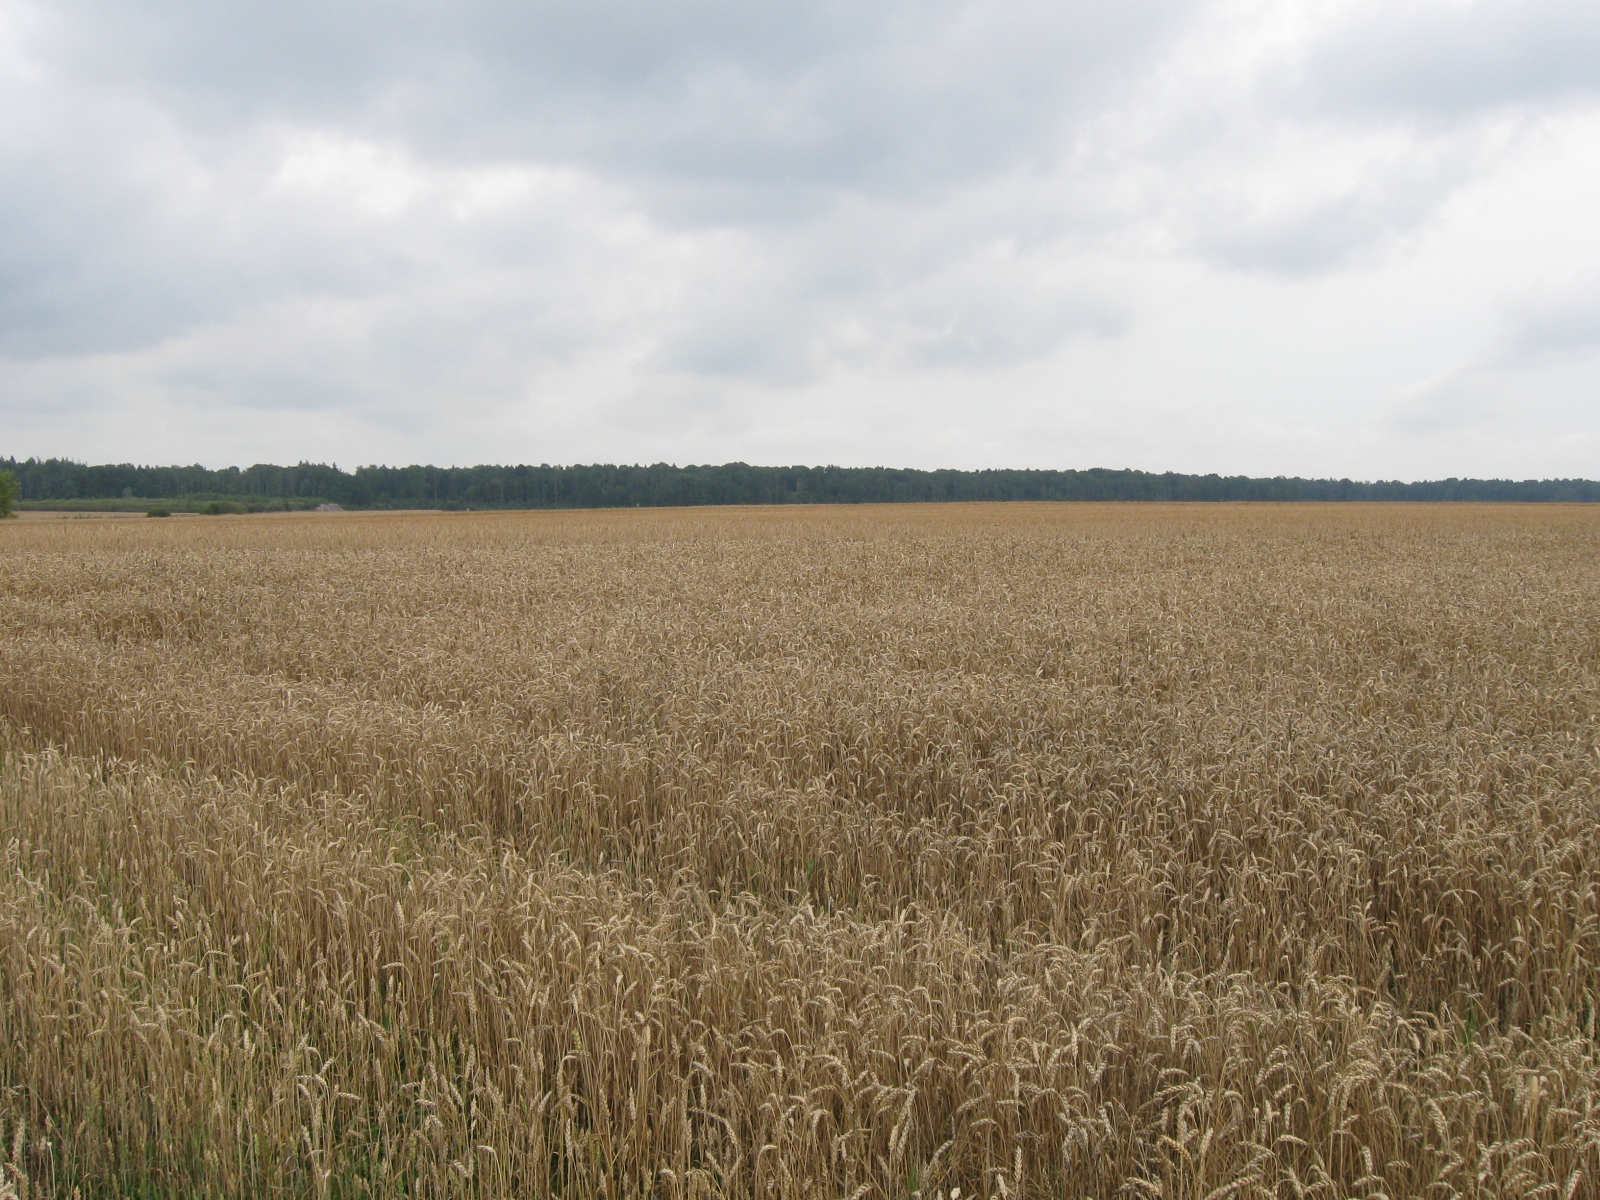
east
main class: Cropland
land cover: Common wheat
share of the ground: > 75 %
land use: Agriculture (excluding fallow land and kitchen gardens)
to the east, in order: Common wheat; Barley; Common wheat
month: August
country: LT
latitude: 54.6465
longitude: 23.5177
